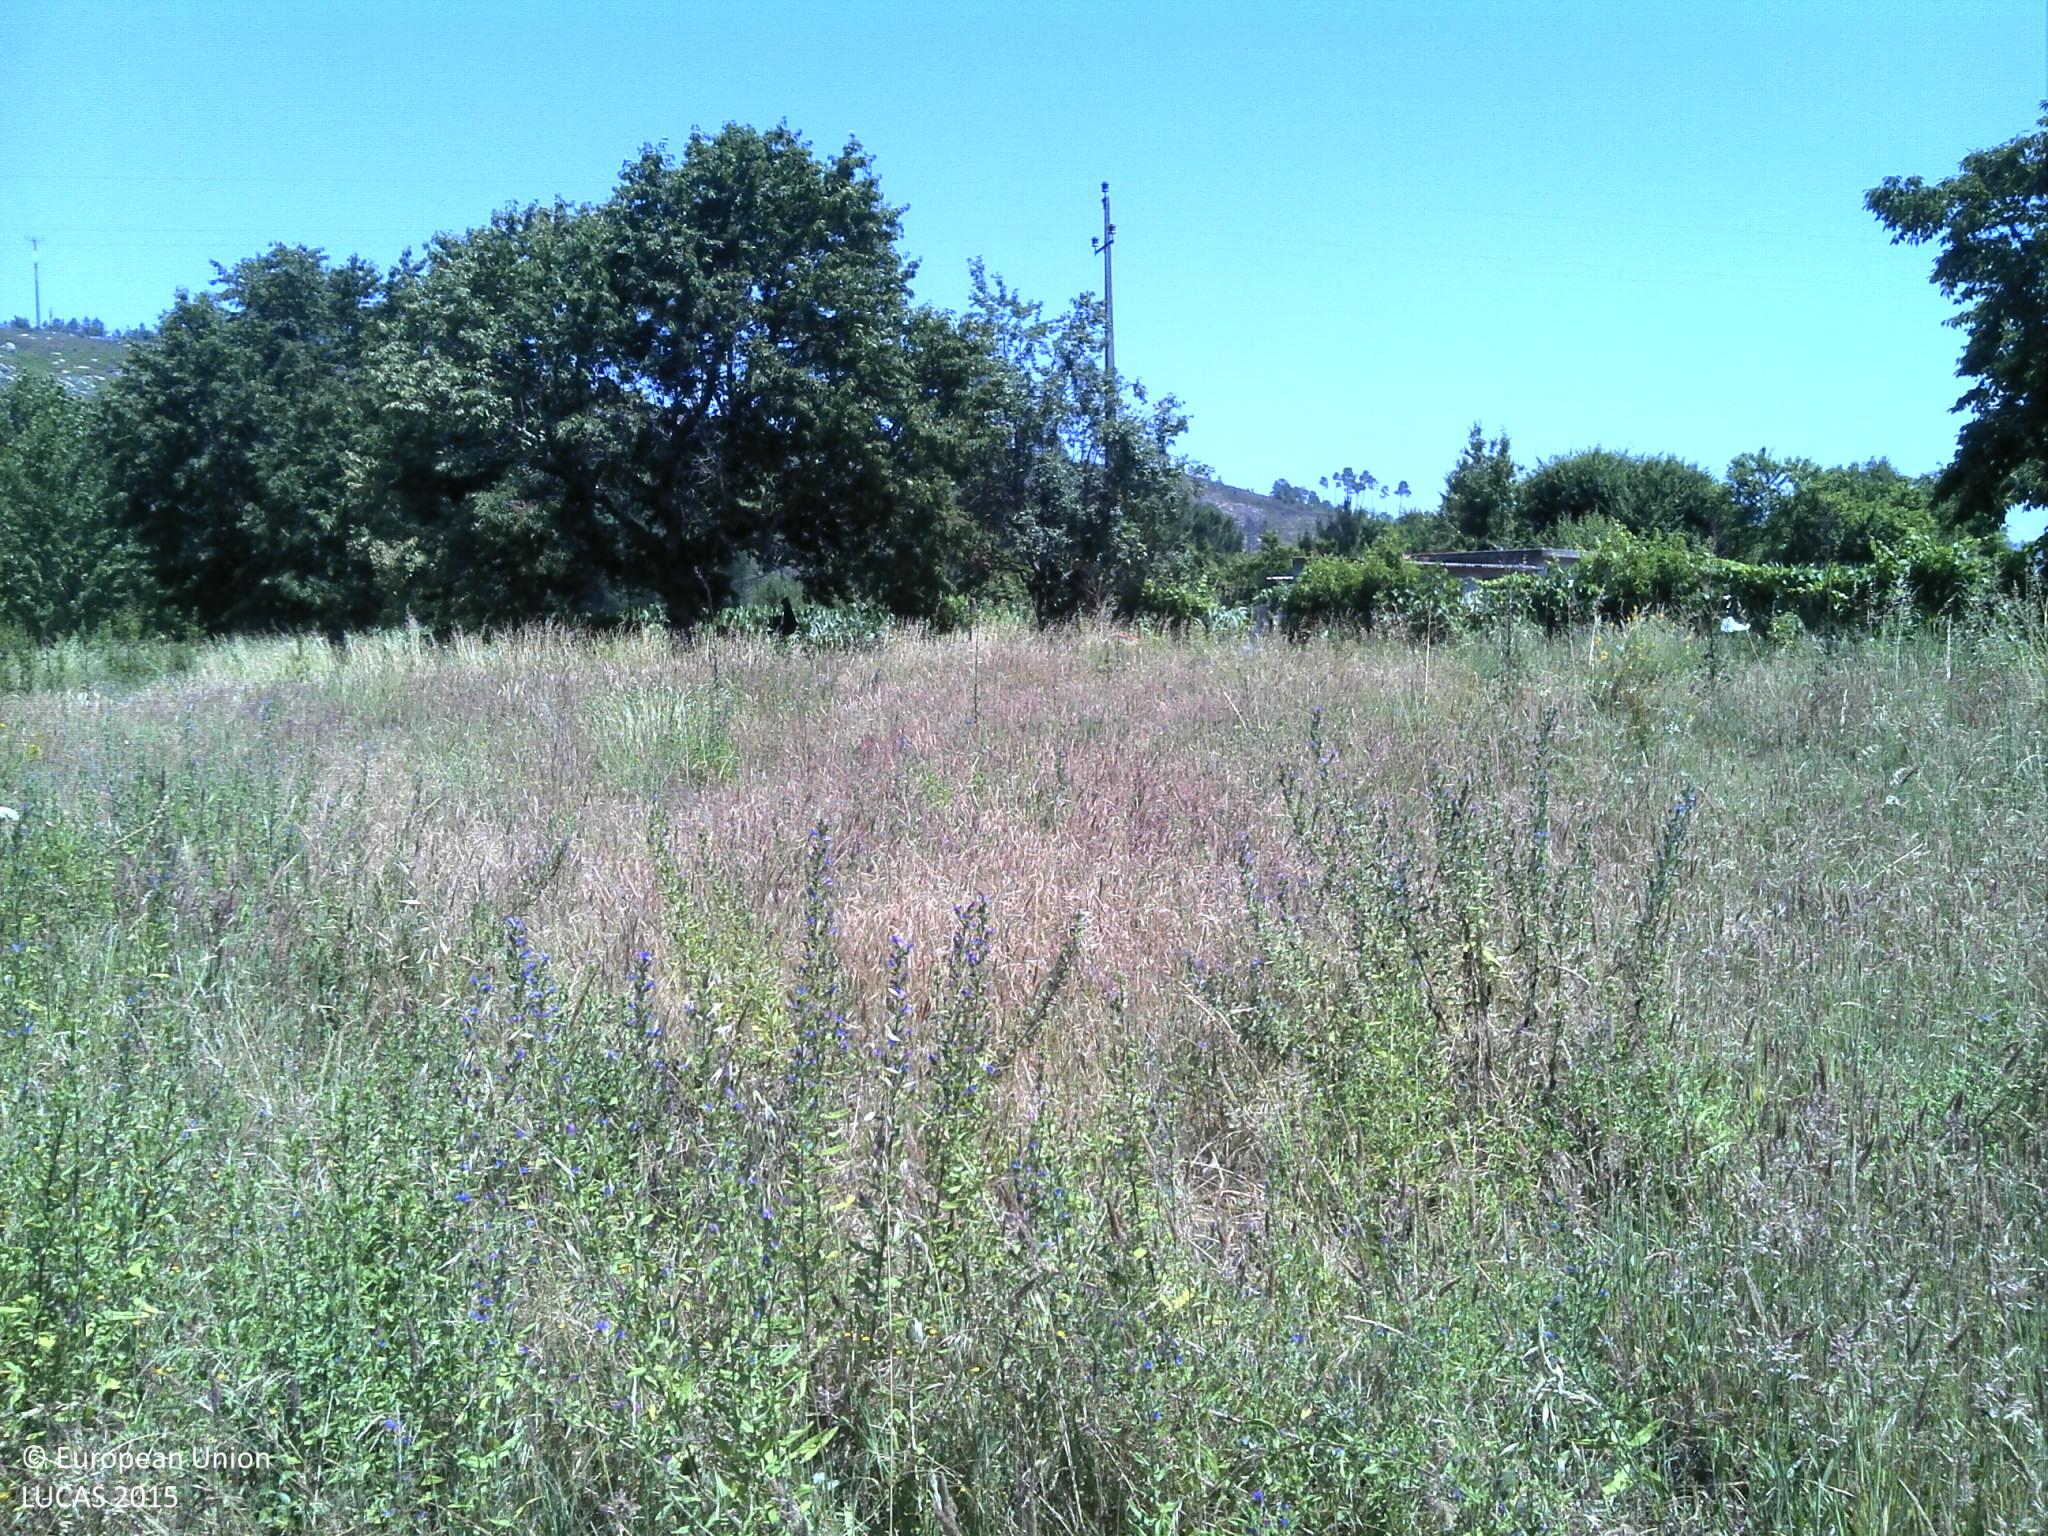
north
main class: Shrubland
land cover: Shrubland without tree cover
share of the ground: > 75 %
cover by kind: shrubs 90 %, unconsolidated bare surface 10 %
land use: Semi-natural and natural areas not in use
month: June
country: PT
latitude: 40.5819
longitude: -7.9031
